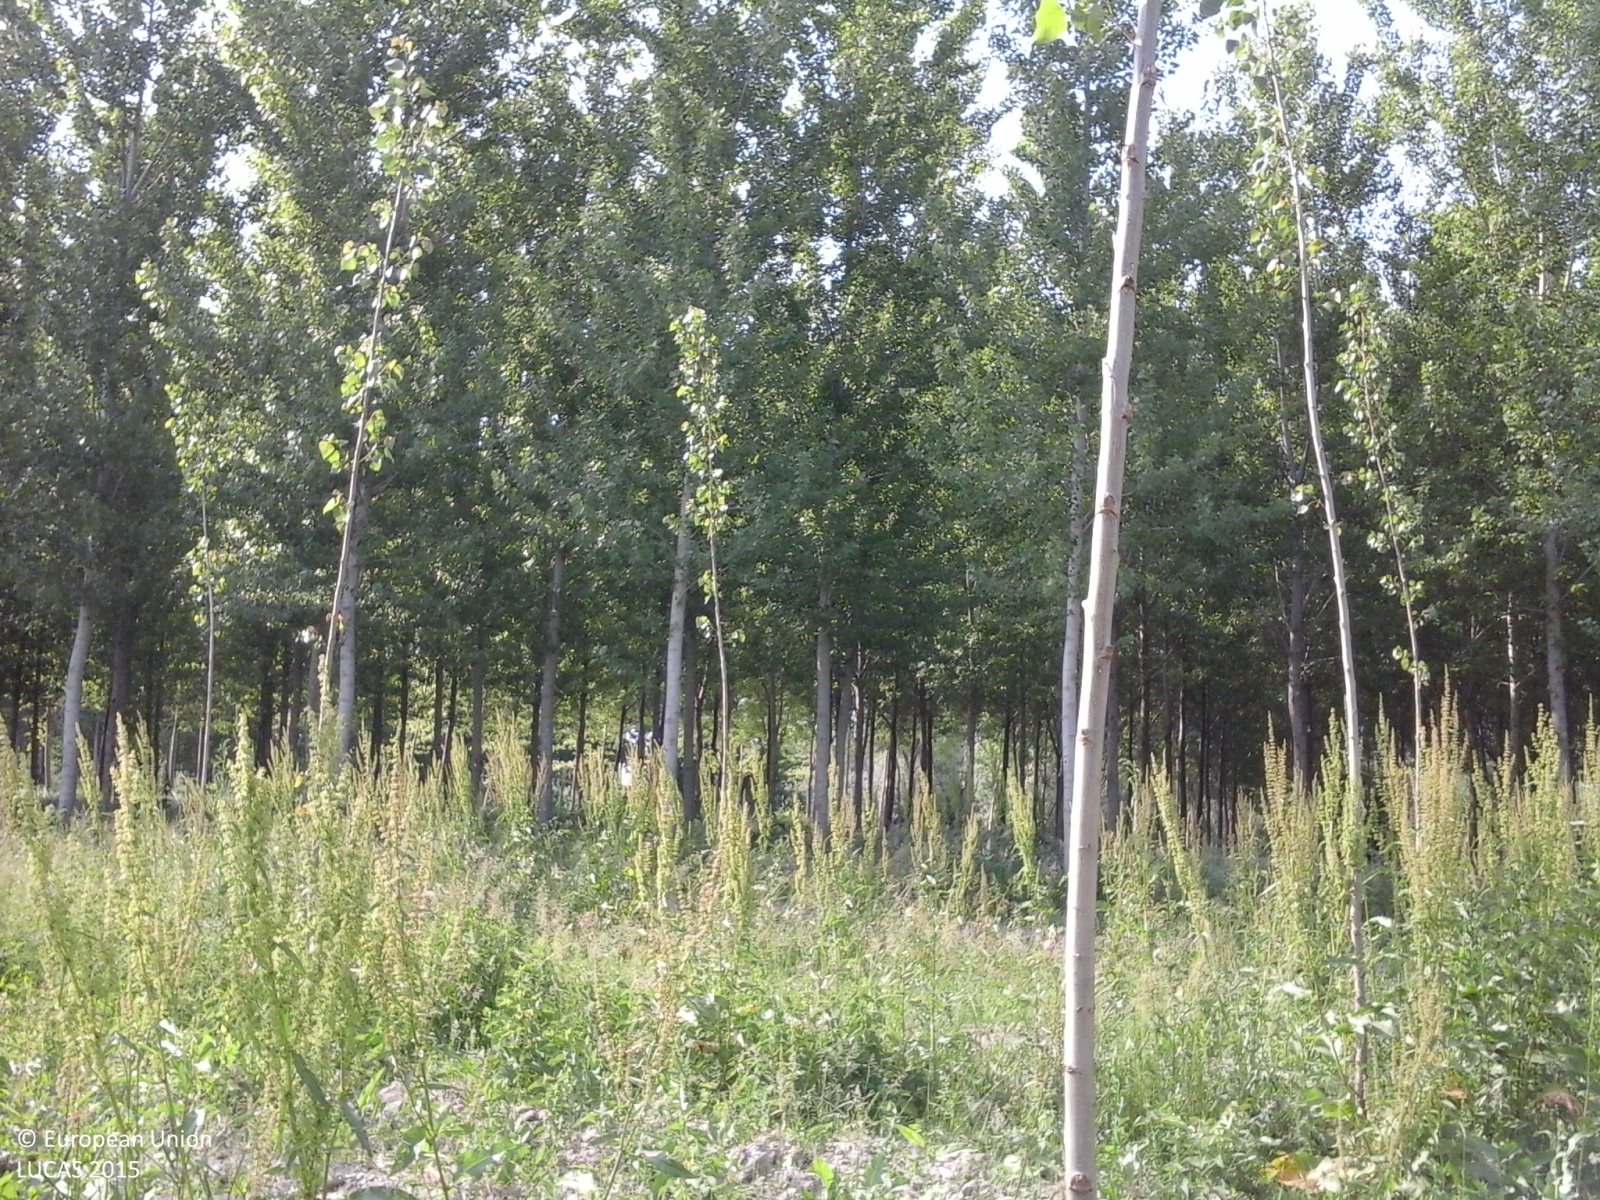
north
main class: Woodland
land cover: Broadleaved woodland
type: exotic forest
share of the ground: 25 - 50 %
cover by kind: herbaceous plants 85 %, broadleaved forest trees 10 %, unconsolidated bare surface 5 %
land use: Forestry
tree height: > 5 m
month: May
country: IT
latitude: 44.9812
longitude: 10.3164
